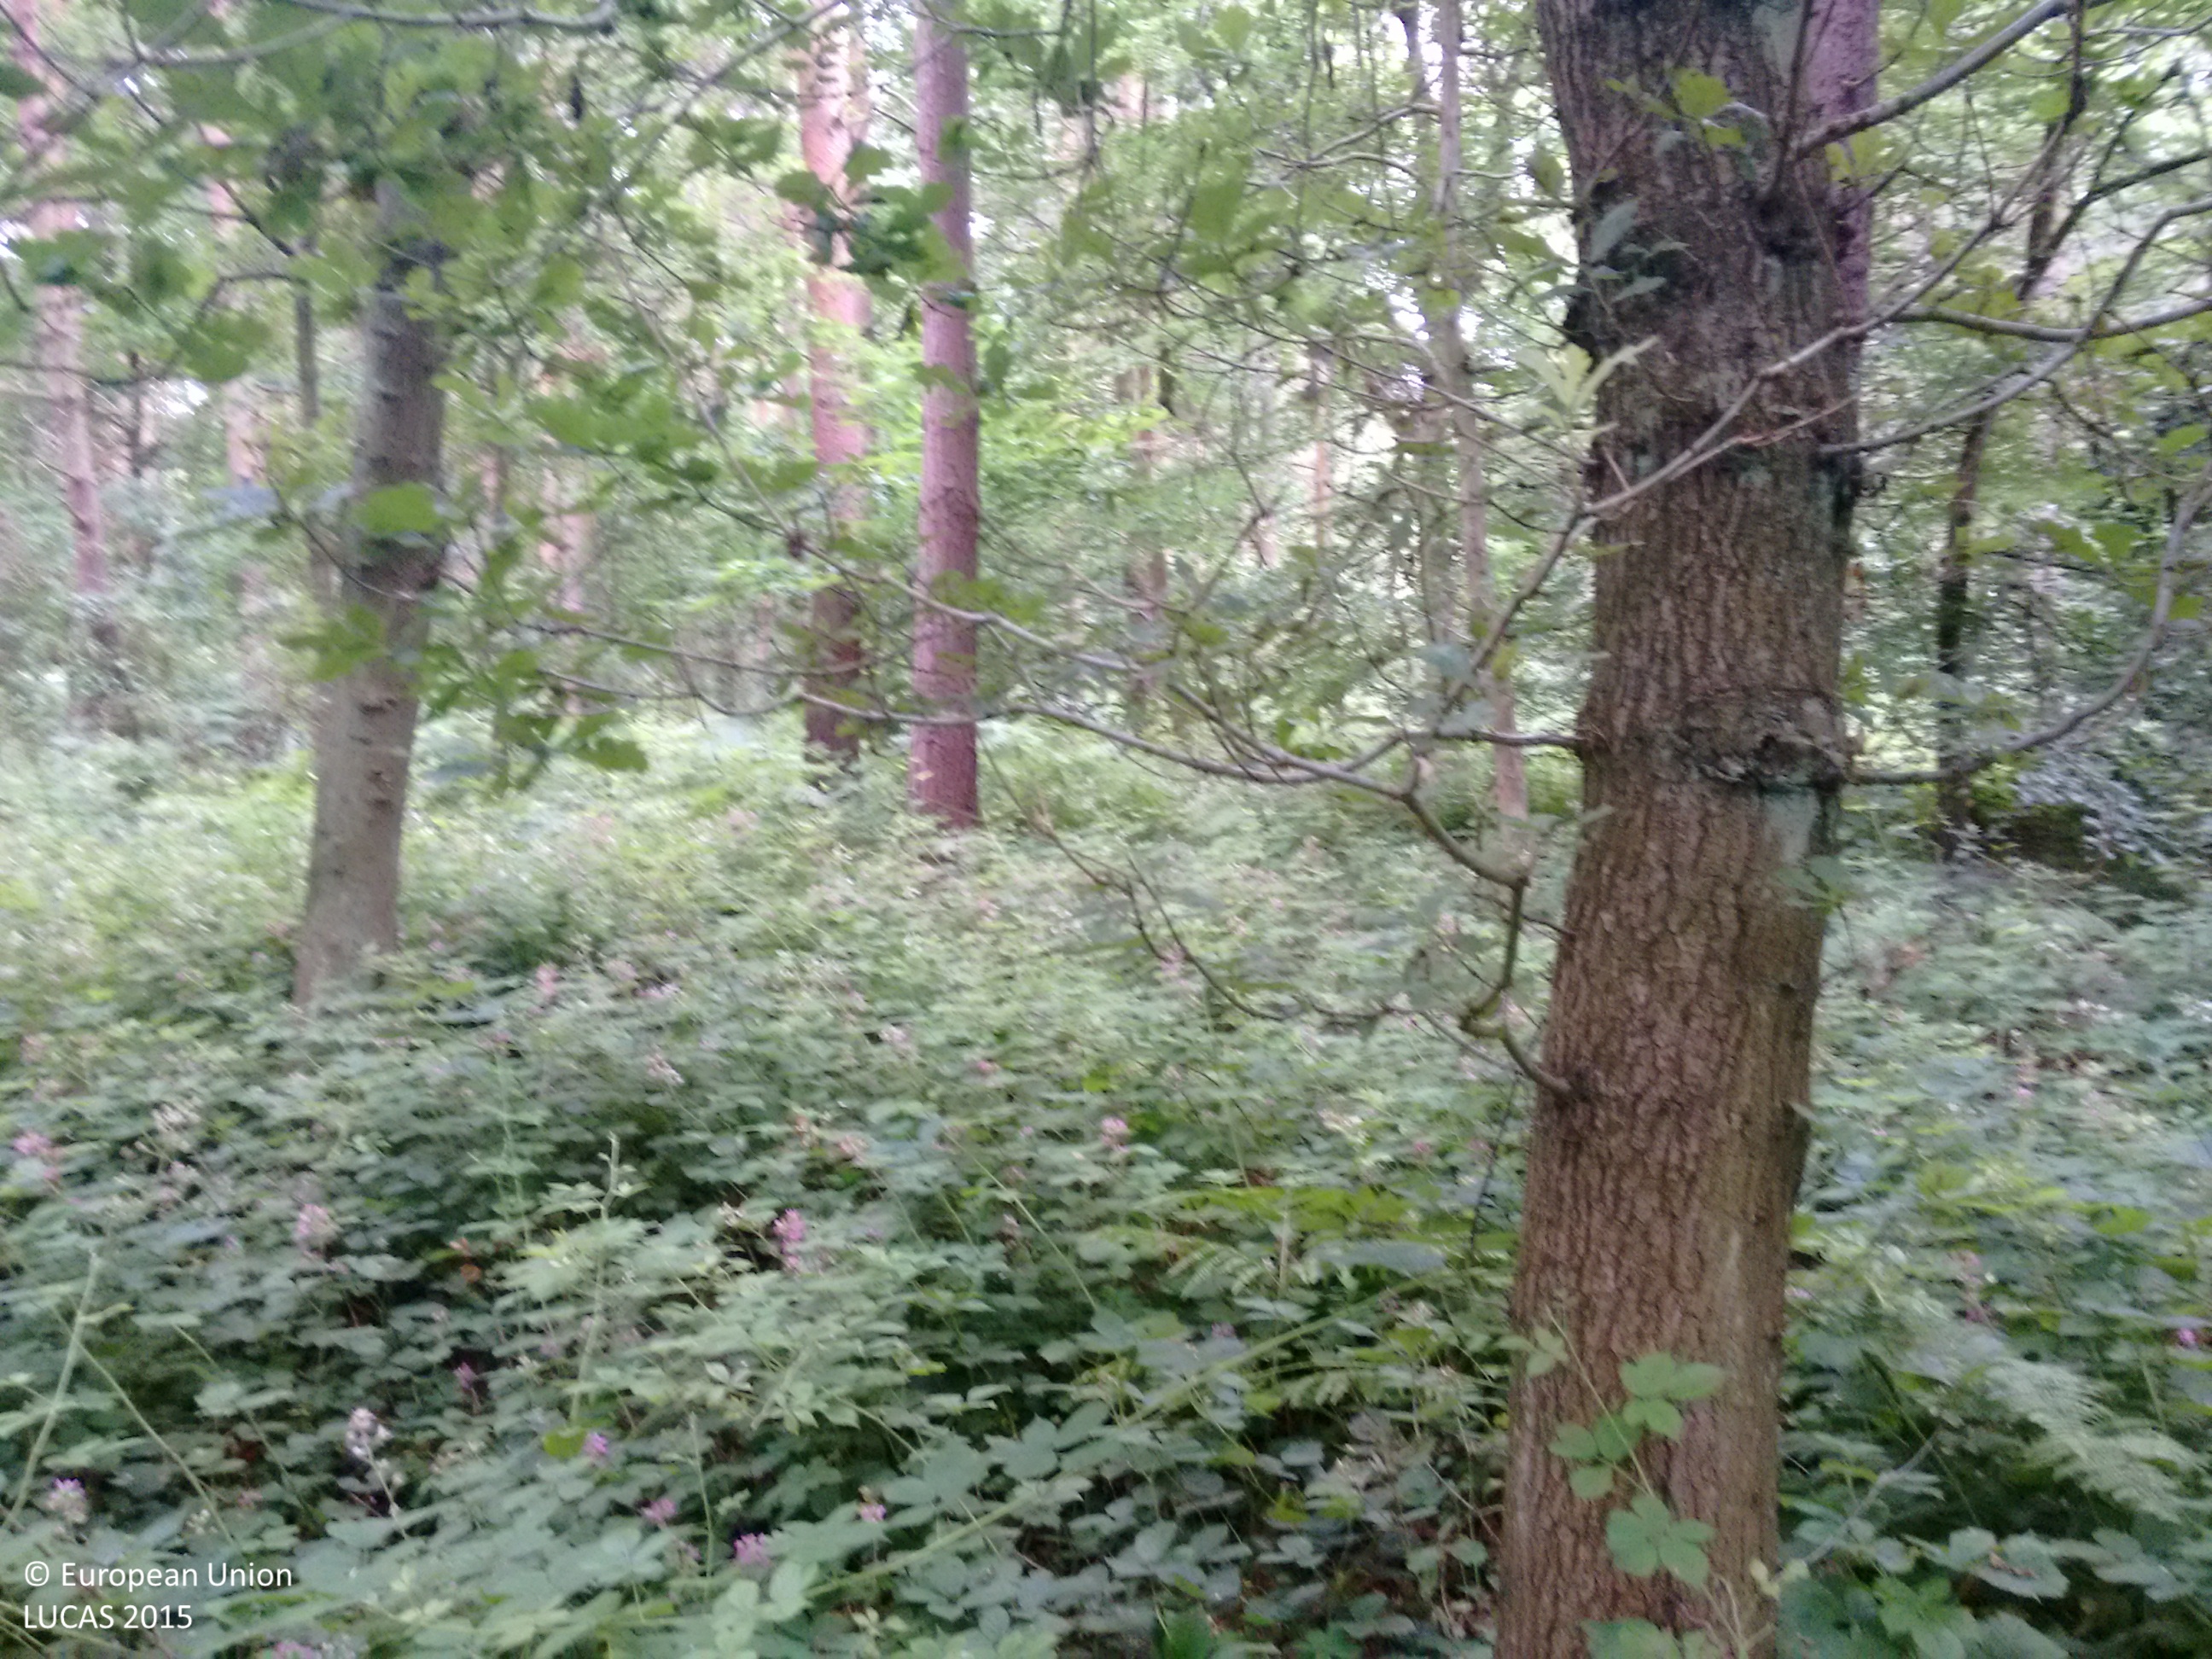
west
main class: Woodland
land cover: Broadleaved woodland
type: mesophytic deciduous forest
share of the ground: > 75 %
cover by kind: broadleaved forest trees 100 %
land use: Amenities, museums, leisure
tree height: > 5 m
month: July
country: GB
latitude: 53.2565
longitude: -1.0618
